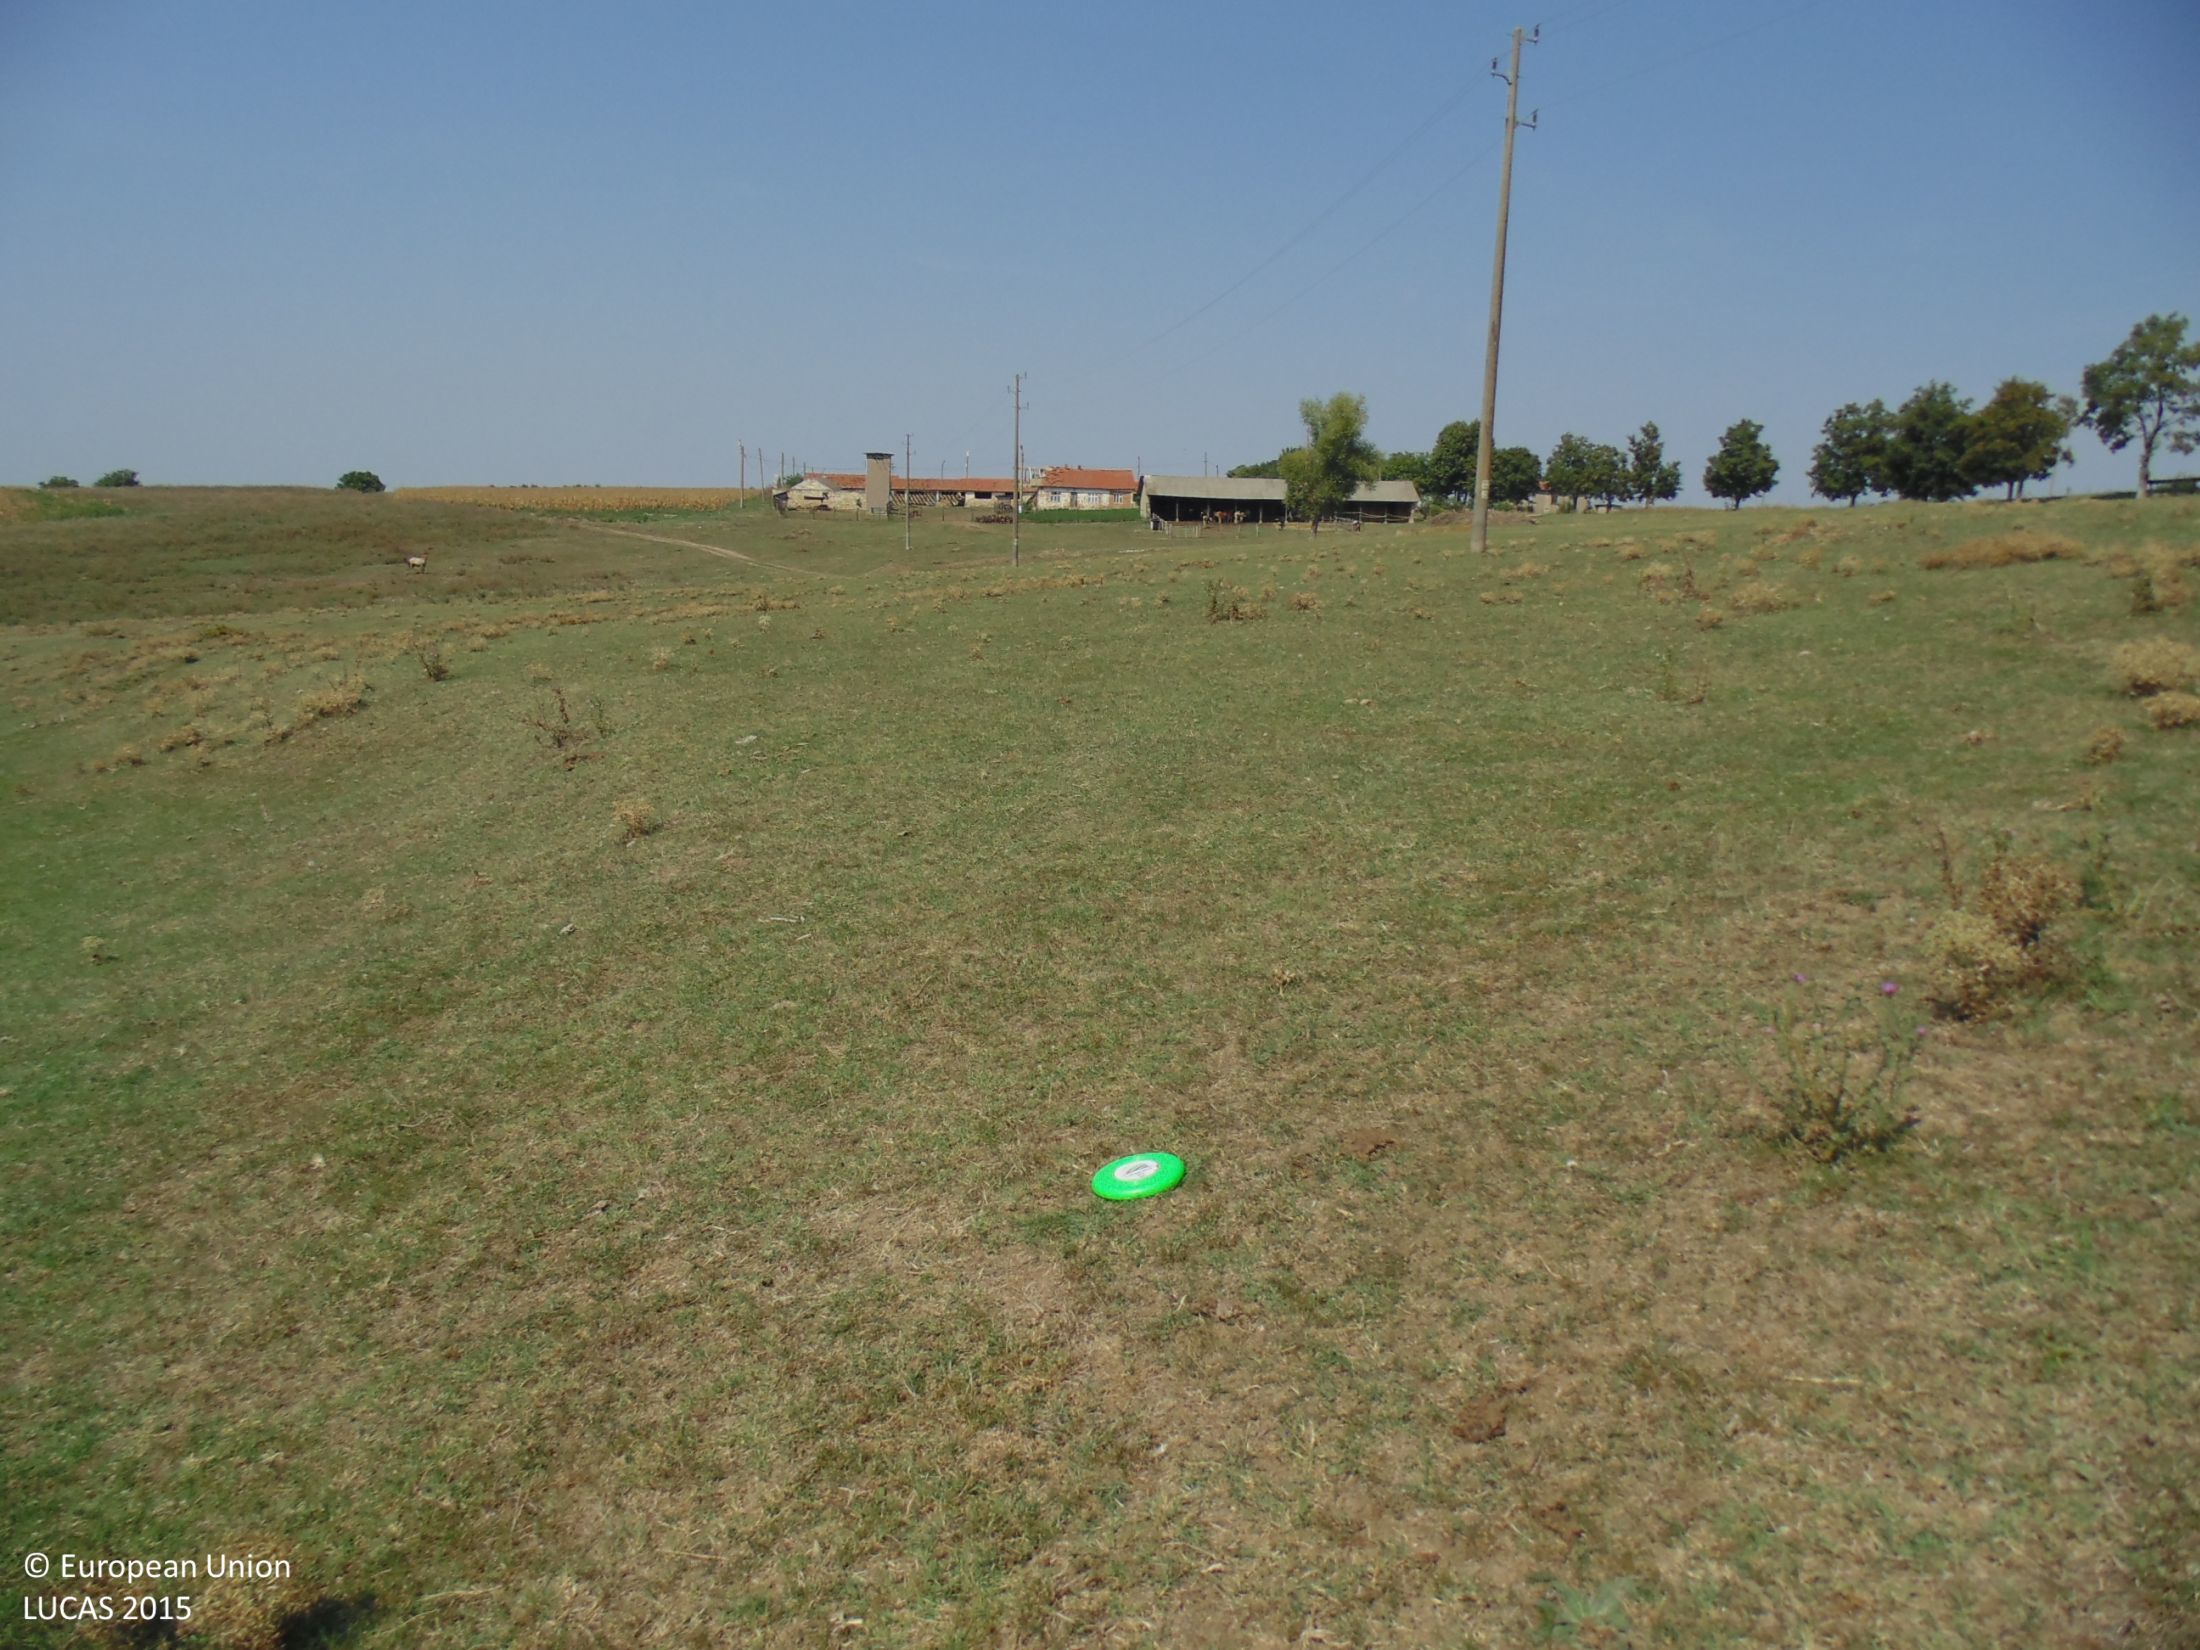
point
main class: Grassland
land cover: Grassland without tree/shrub cover
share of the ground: > 75 %
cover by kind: herbaceous plants 100 %
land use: Agriculture (excluding fallow land and kitchen gardens)
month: September
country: BG
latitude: 43.7928
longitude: 26.9338
